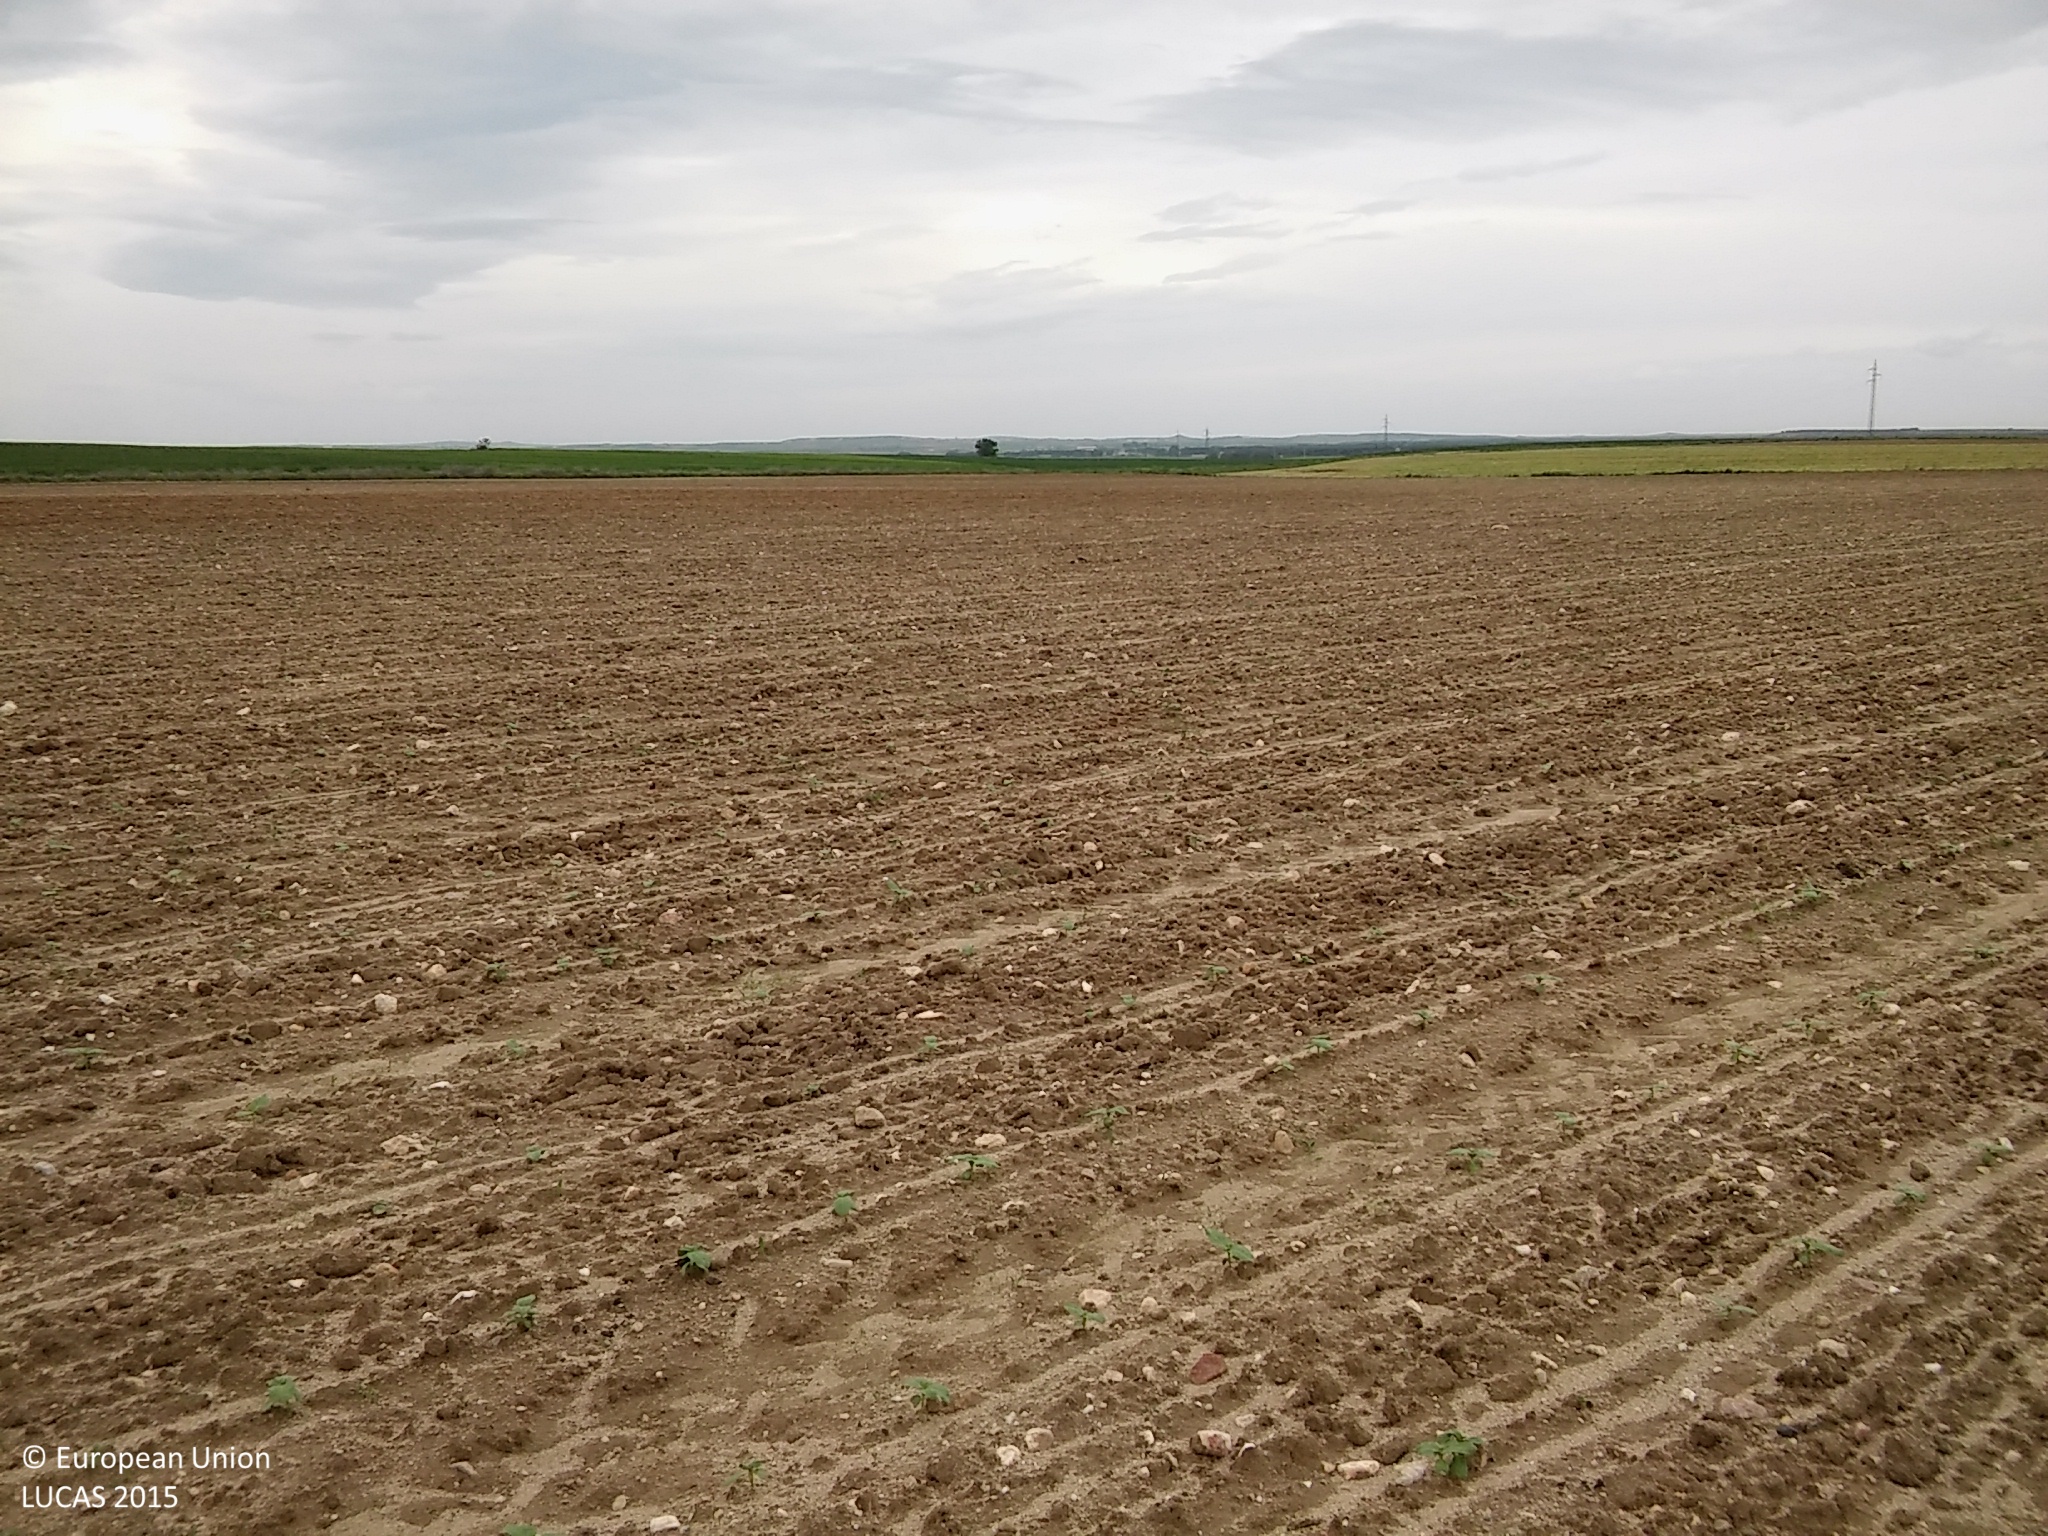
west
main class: Cropland
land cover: Sunflower
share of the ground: < 10 %
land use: Agriculture (excluding fallow land and kitchen gardens)
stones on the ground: 25 - 50 %
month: May
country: ES
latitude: 41.1493
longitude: -4.1008
